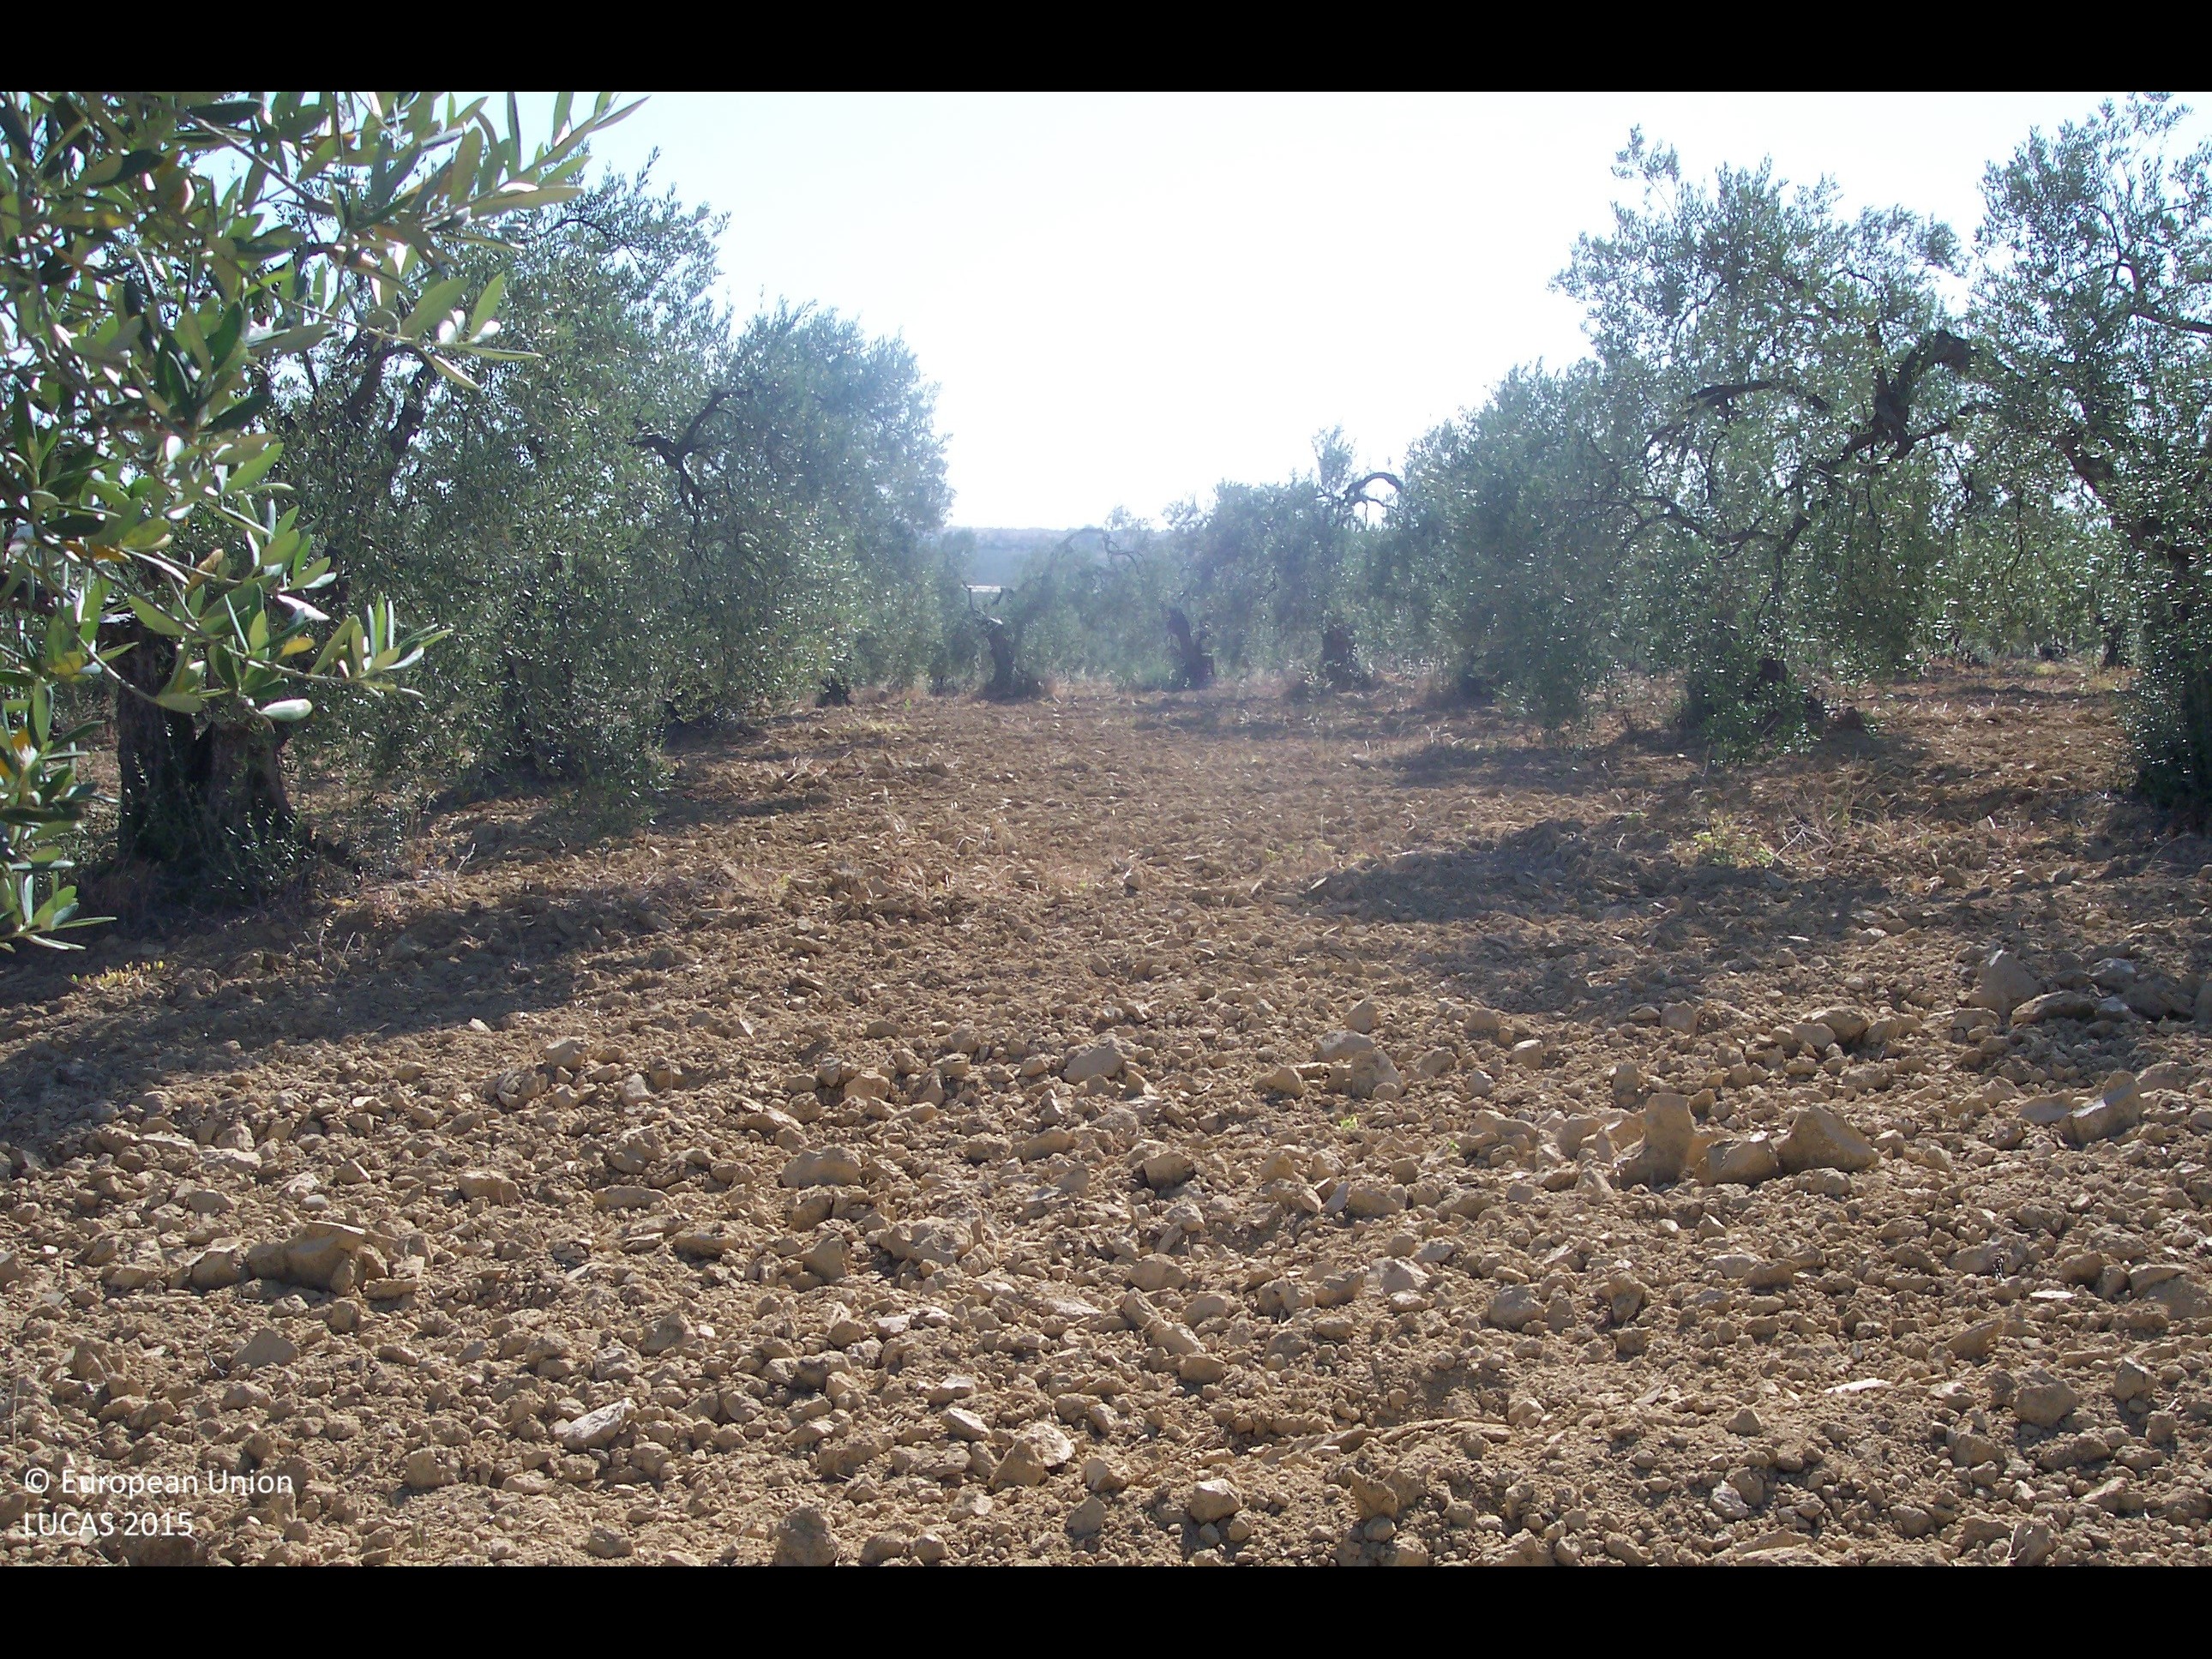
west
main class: Cropland
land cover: Olive groves
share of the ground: 25 - 50 %
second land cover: Other bare soil
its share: > 75 %
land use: Agriculture (excluding fallow land and kitchen gardens)
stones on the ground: < 10 %
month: June
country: ES
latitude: 37.3809
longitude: -6.0961
